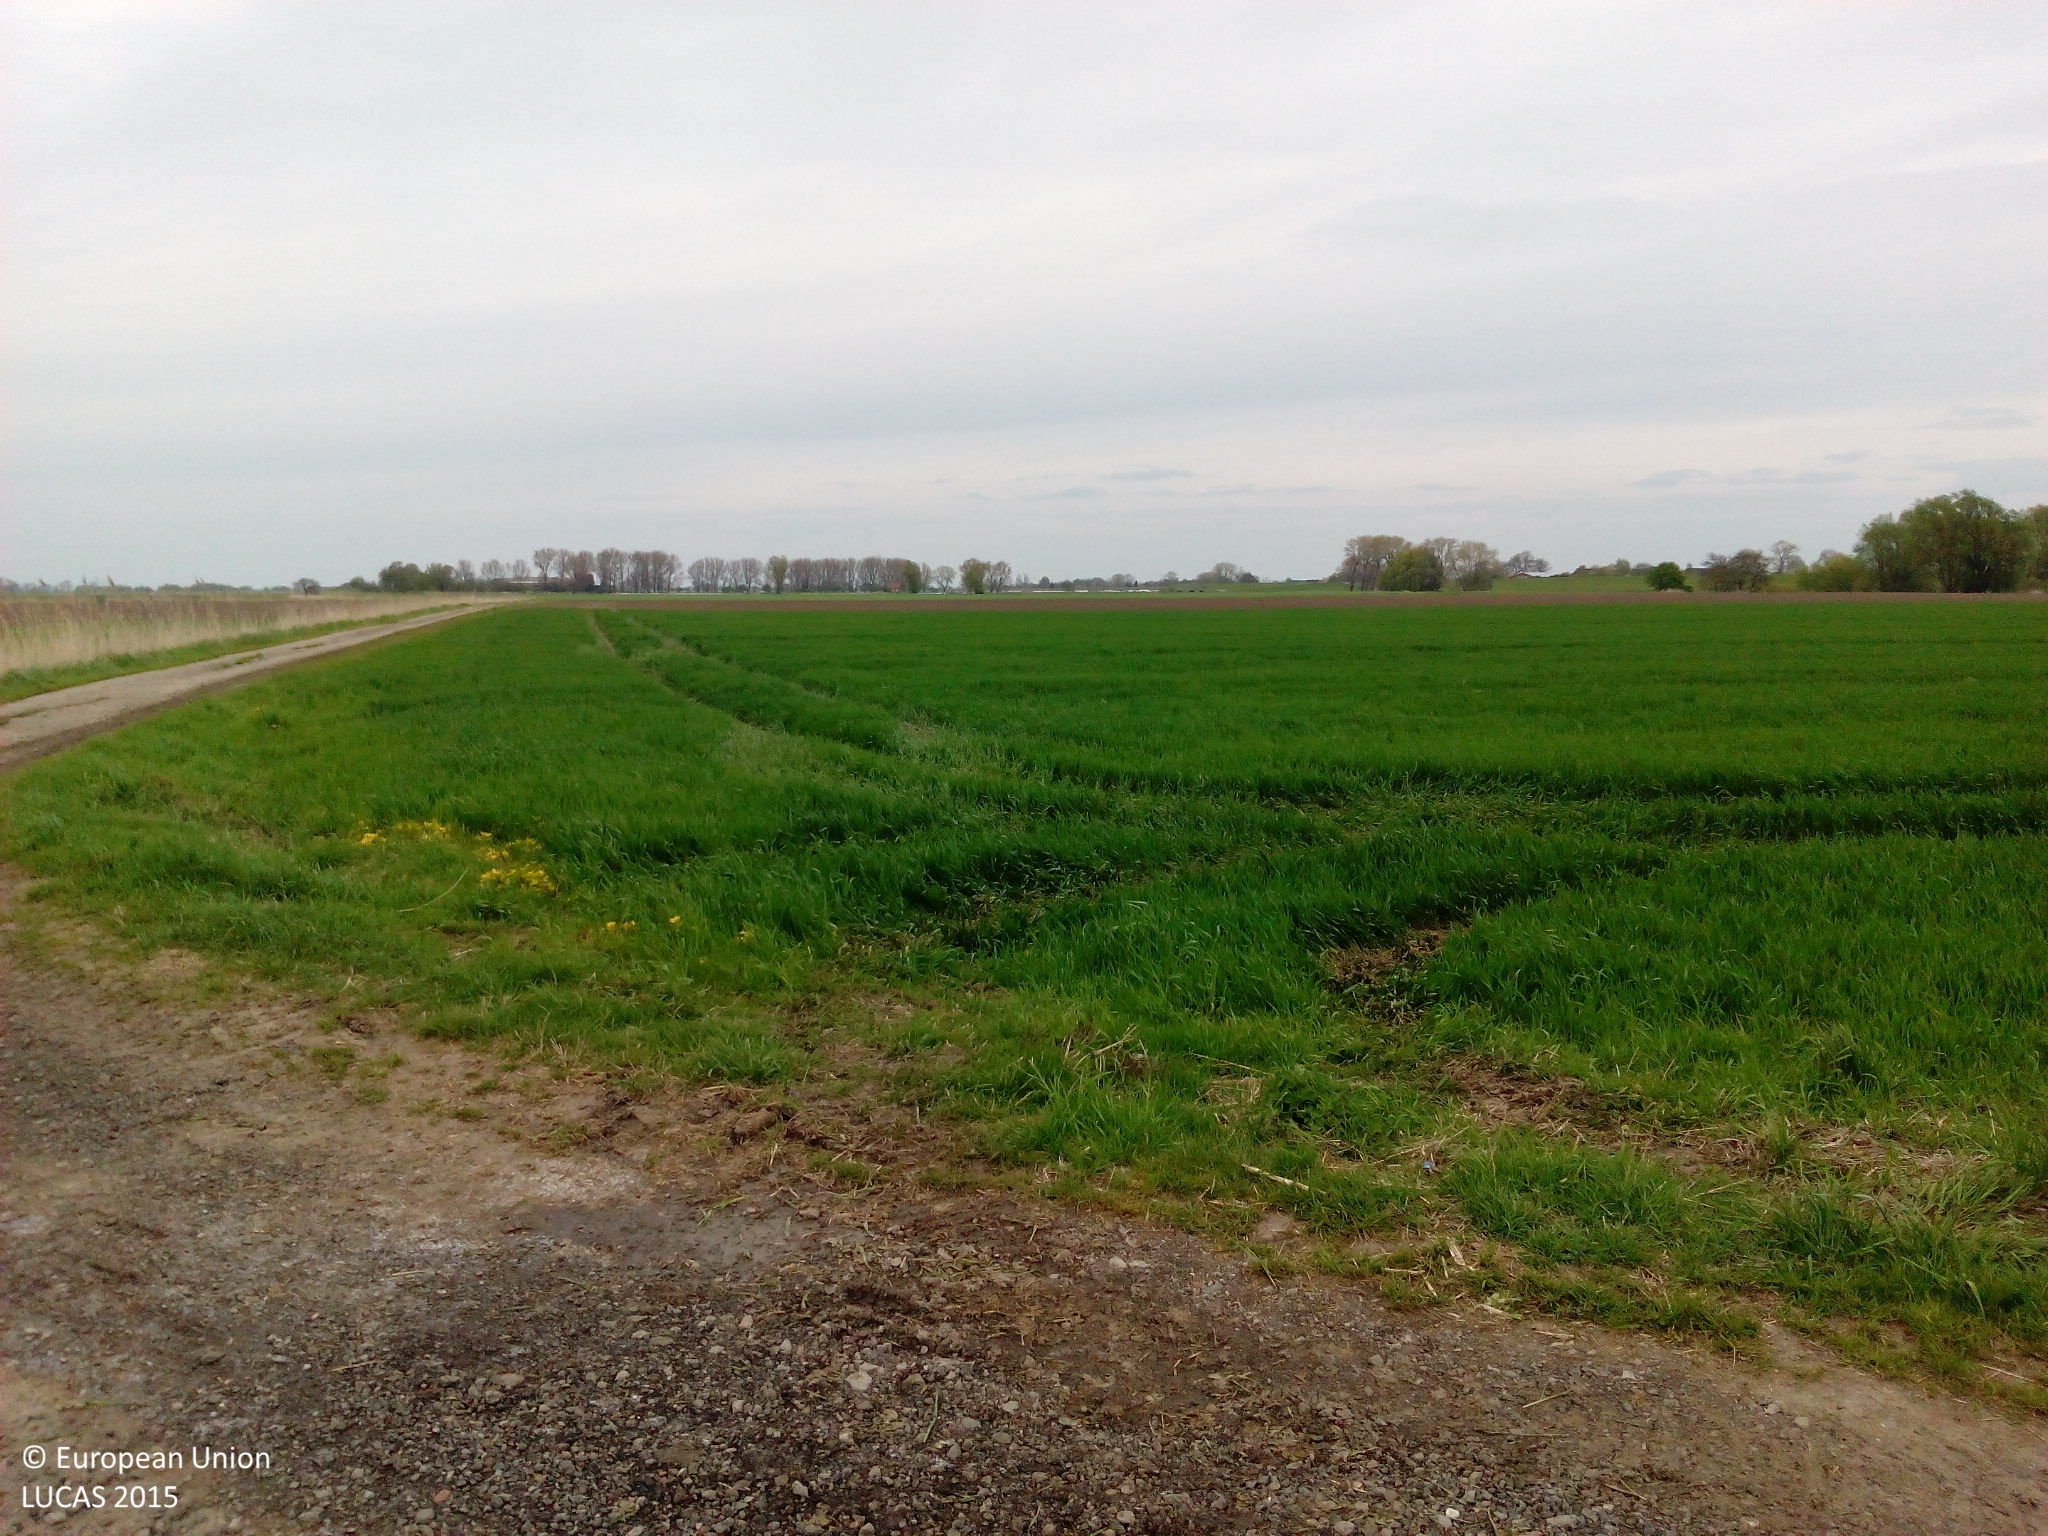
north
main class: Grassland
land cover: Grassland without tree/shrub cover
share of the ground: > 75 %
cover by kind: herbaceous plants 100 %
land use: Agriculture (excluding fallow land and kitchen gardens)
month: May
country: DE
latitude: 53.2850
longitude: 8.5156
